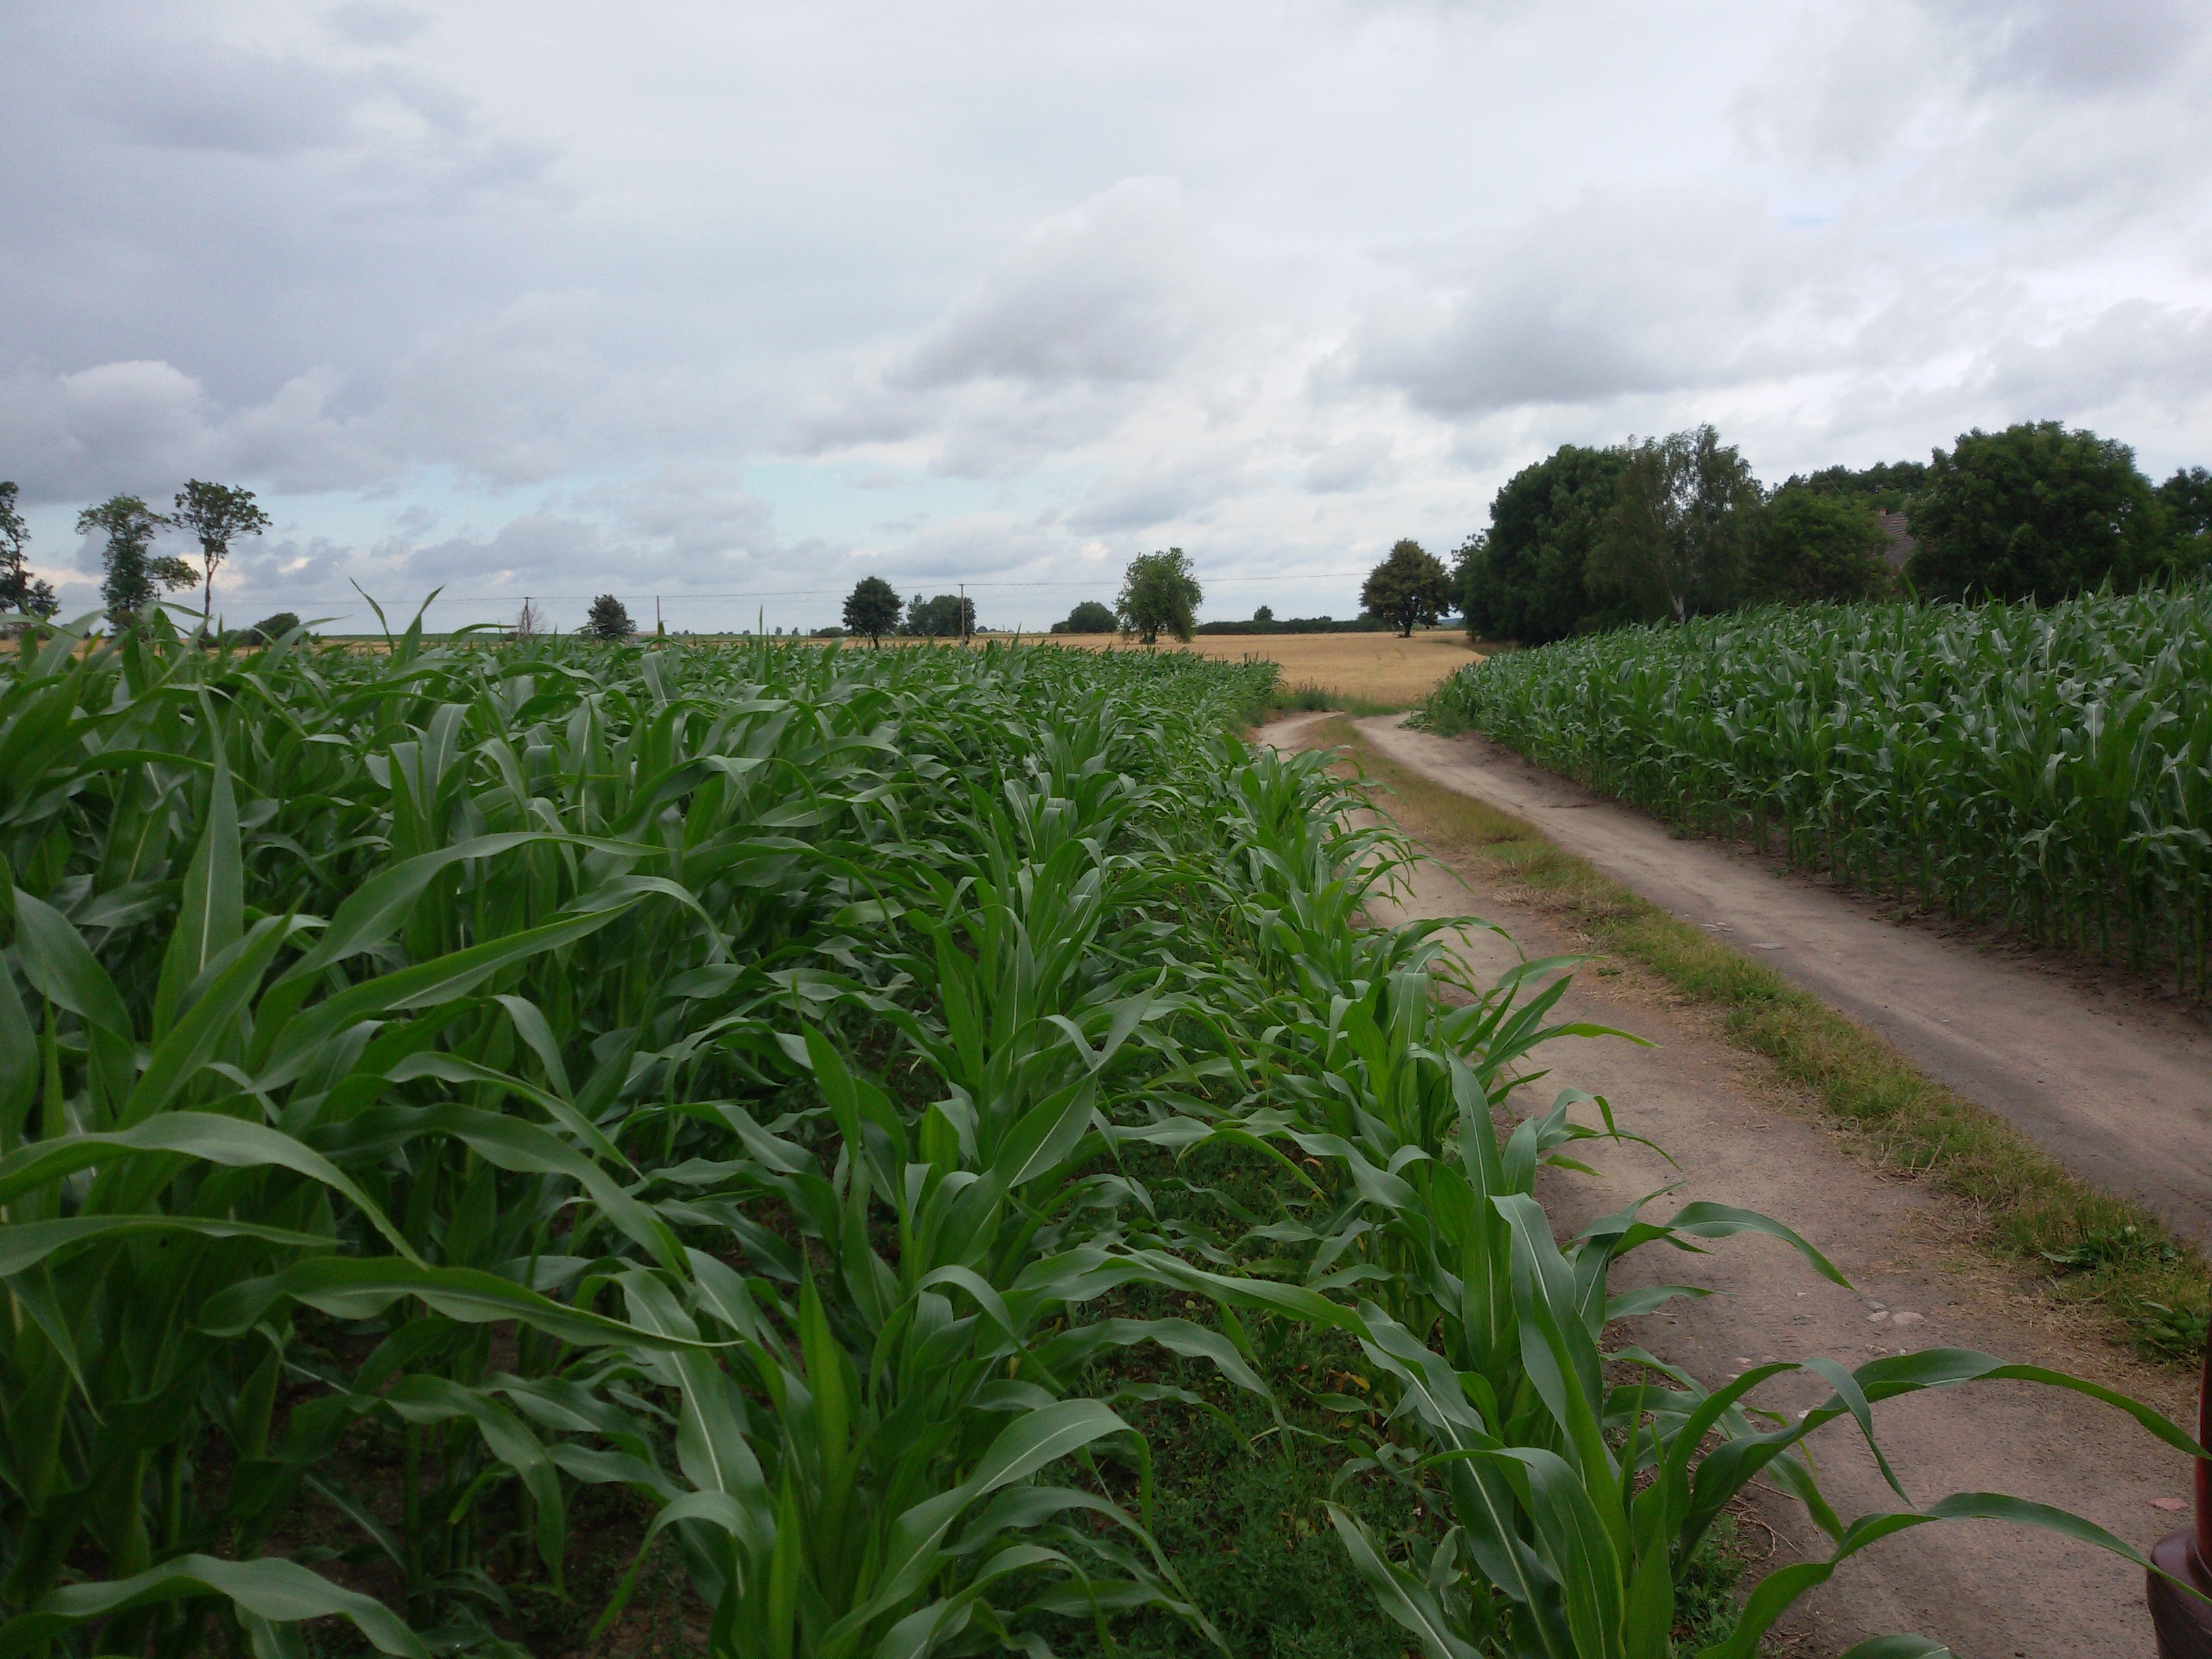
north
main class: Cropland
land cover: Maize
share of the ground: > 75 %
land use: Agriculture (excluding fallow land and kitchen gardens)
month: July
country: PL
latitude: 52.8540
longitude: 17.6313
